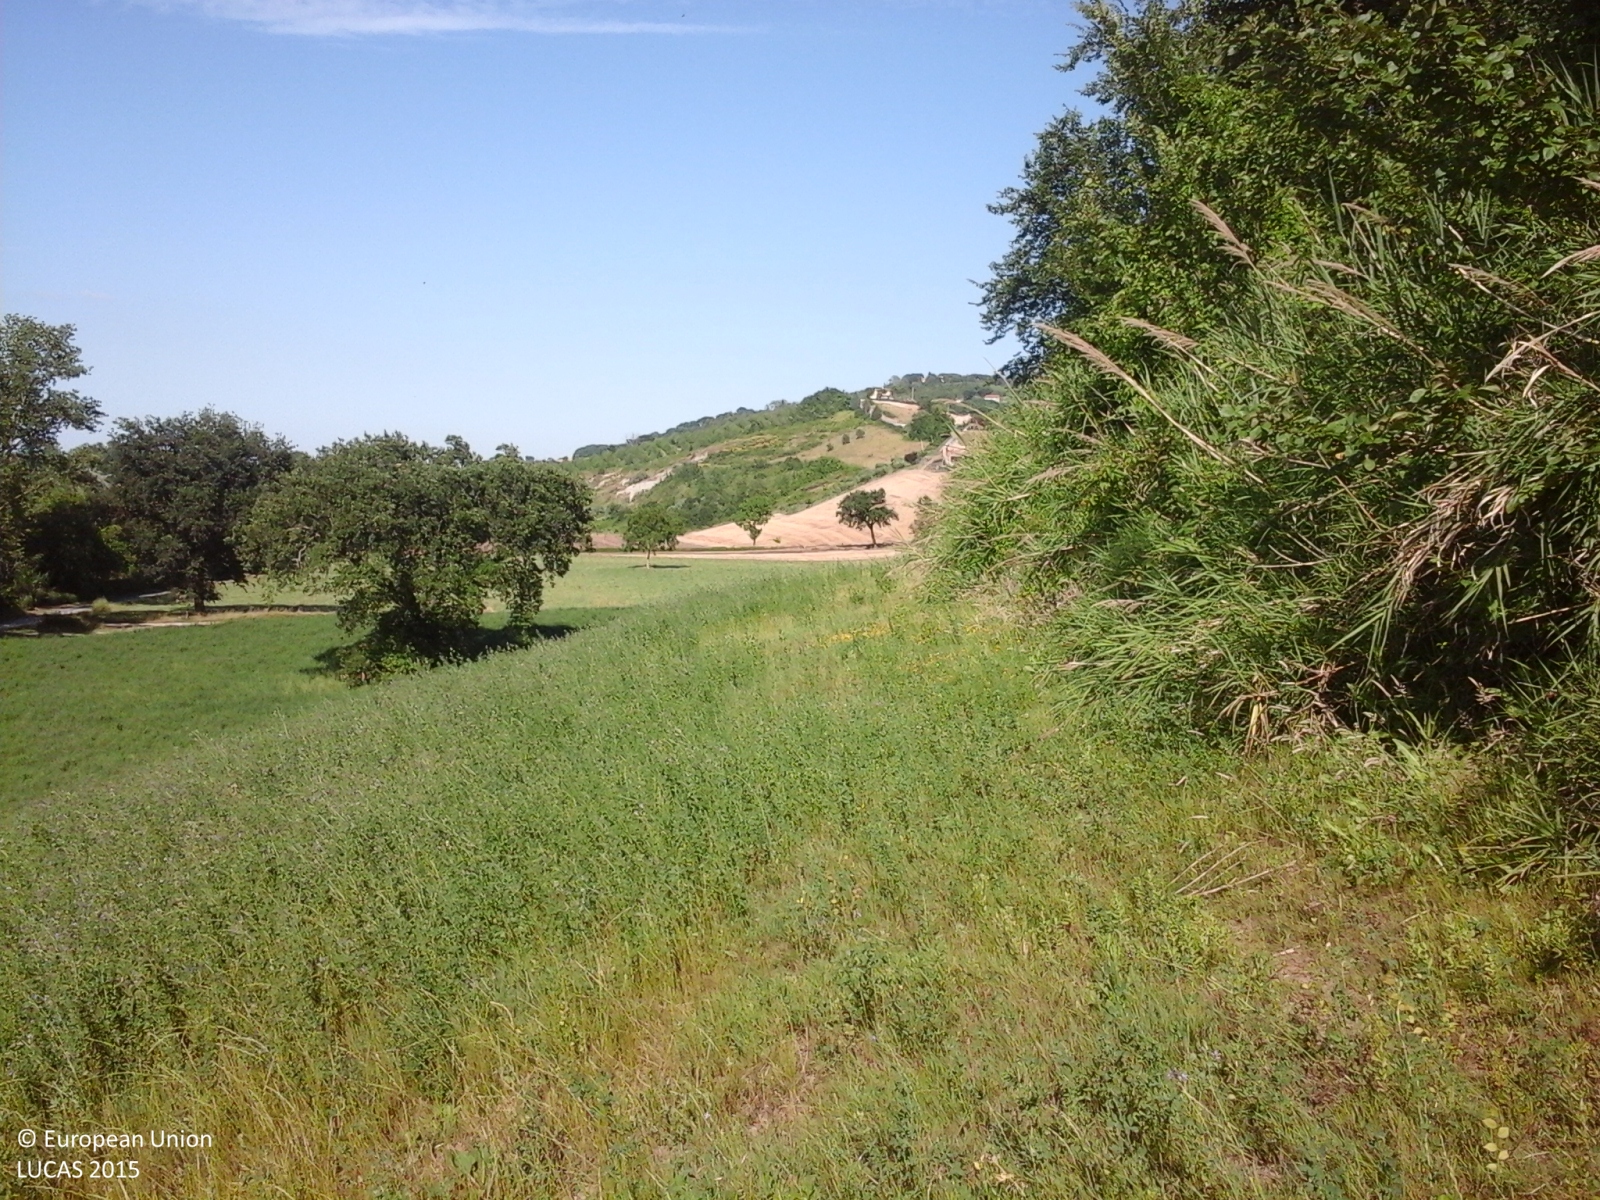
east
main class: Woodland
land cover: Broadleaved woodland
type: thermophilous deciduous forest
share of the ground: > 75 %
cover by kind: broadleaved forest trees 90 %, shrubs 5 %, herbaceous plants 5 %
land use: Forestry
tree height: > 5 m
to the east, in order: Broadleaved woodland; Shrubland with sparse tree cover; Broadleaved woodland; Fences; Tracks; Broadleaved woodland; Temporary grasslands; Clovers
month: June
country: IT
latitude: 43.3359
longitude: 13.4571
